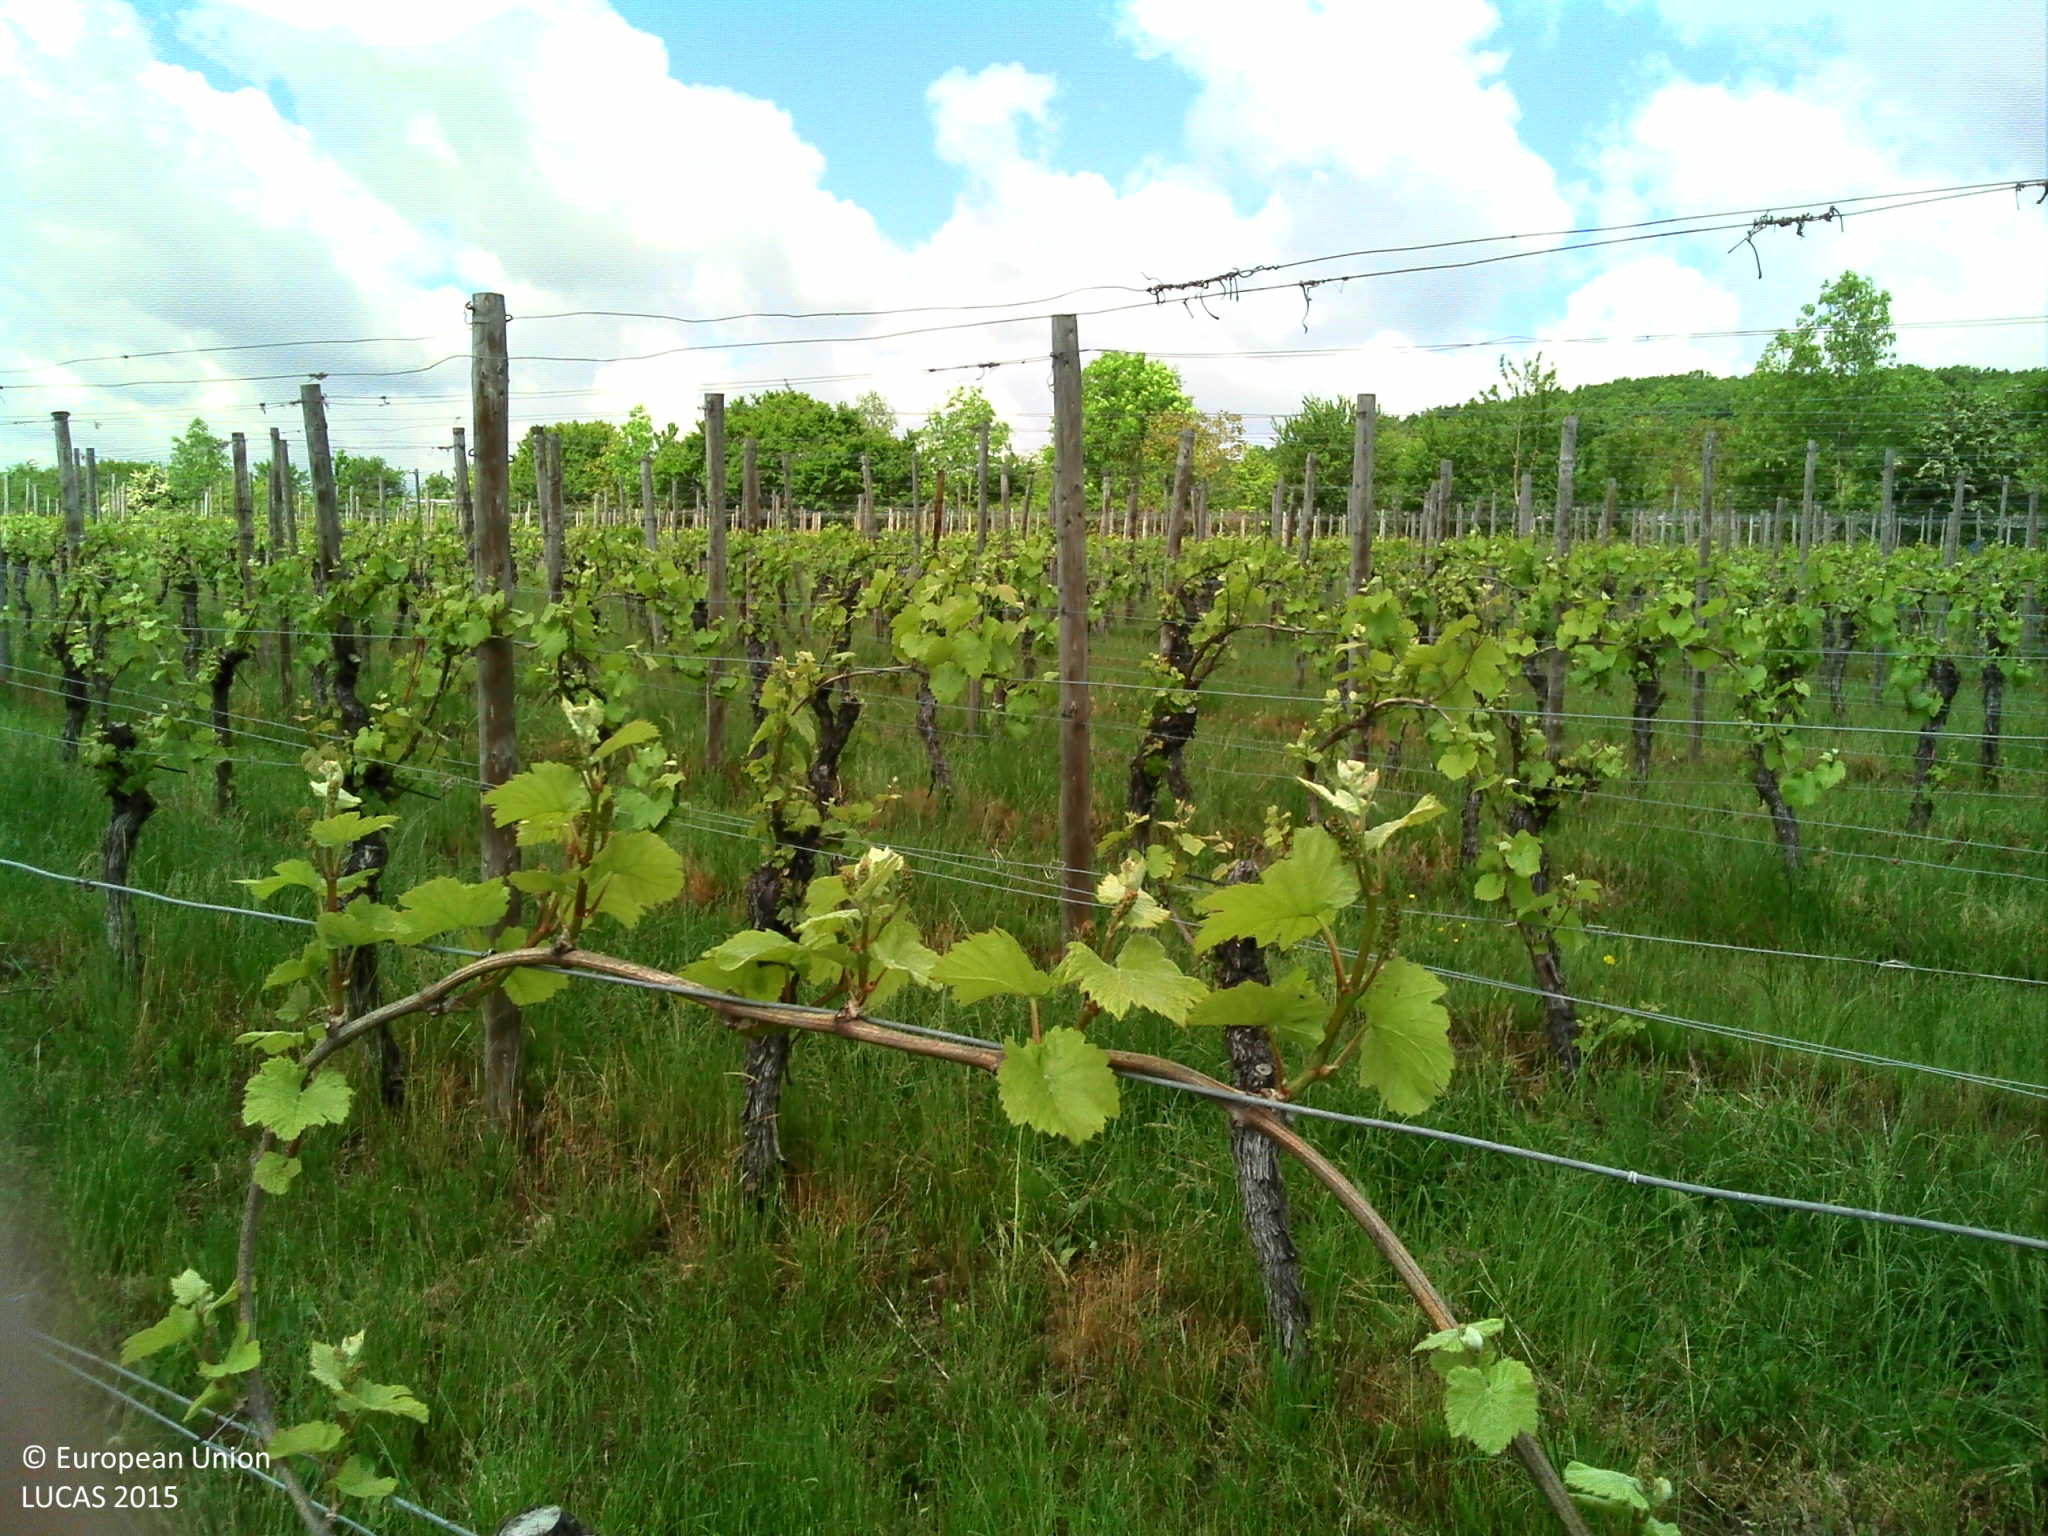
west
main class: Cropland
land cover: Vineyards
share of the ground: > 75 %
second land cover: Spontaneously vegetated surfaces
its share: > 75 %
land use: Agriculture (excluding fallow land and kitchen gardens)
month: May
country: LU
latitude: 49.6974
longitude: 6.4644
